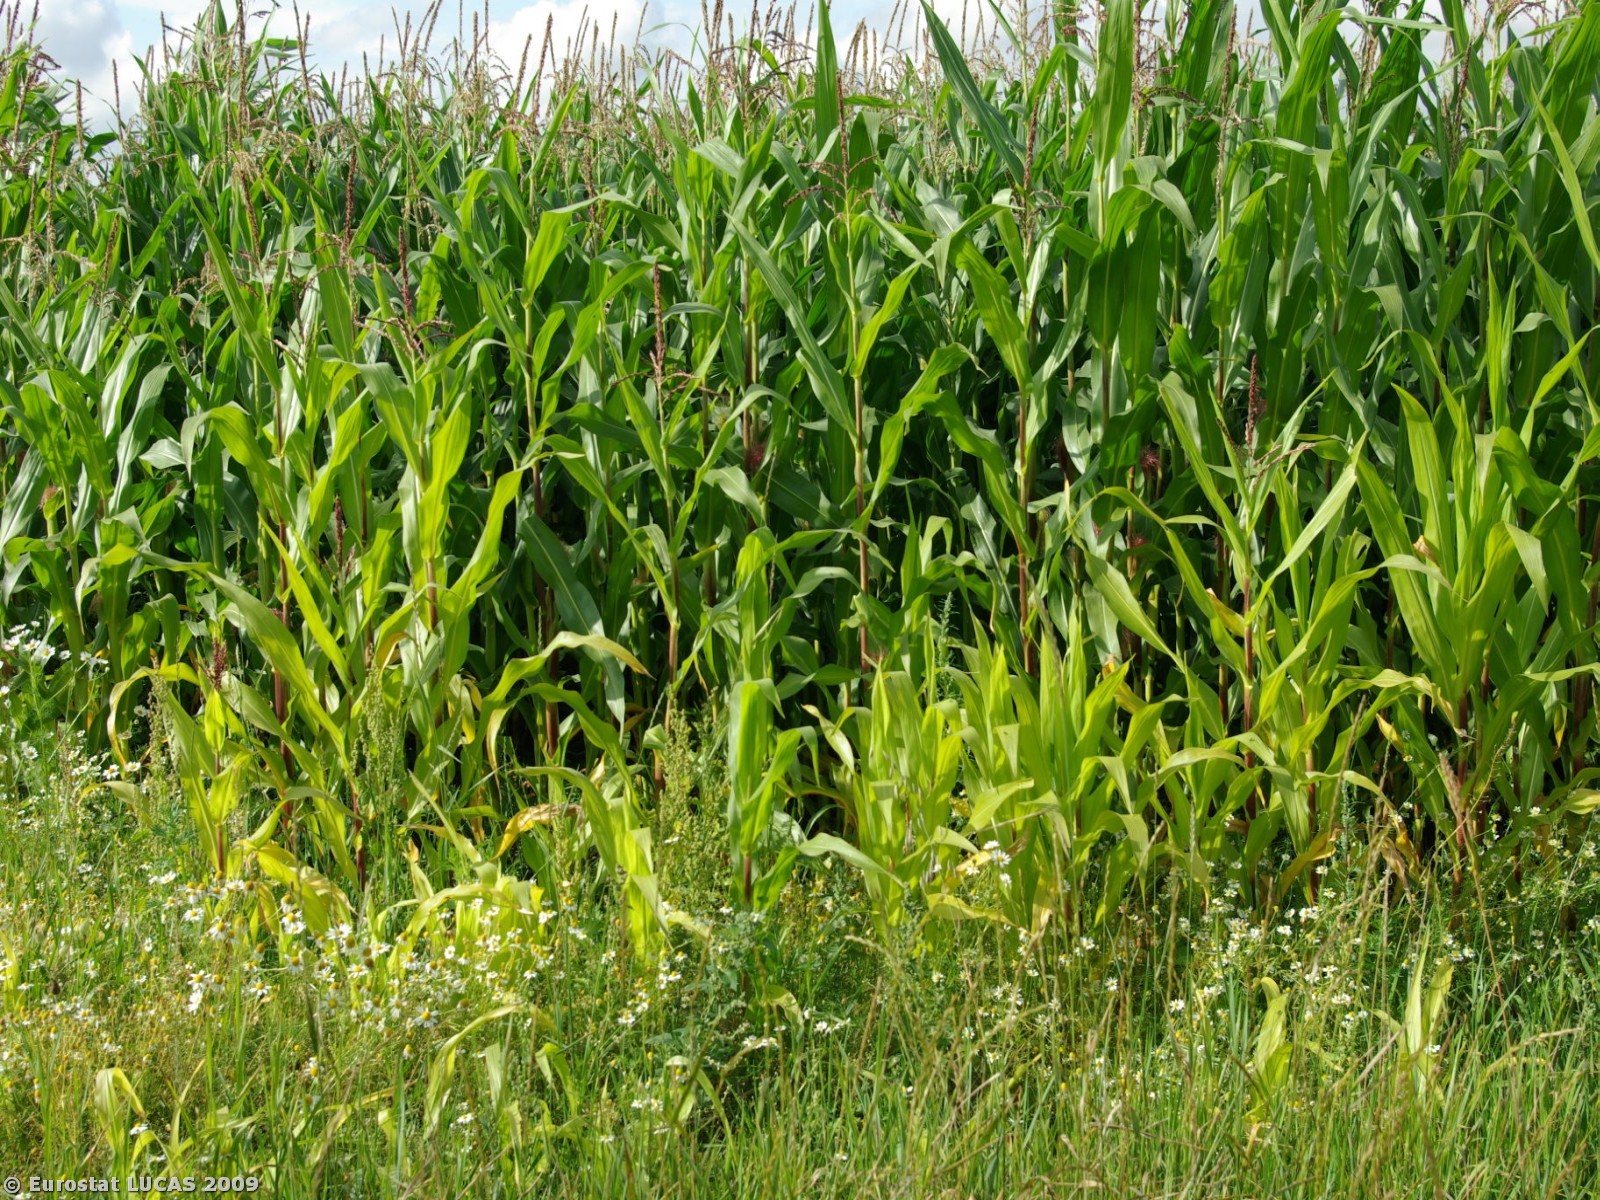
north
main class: Grassland
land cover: Grassland without tree/shrub cover
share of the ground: > 75 %
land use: Agriculture (excluding fallow land and kitchen gardens)
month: July
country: DK
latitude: 55.2119
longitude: 8.8537
